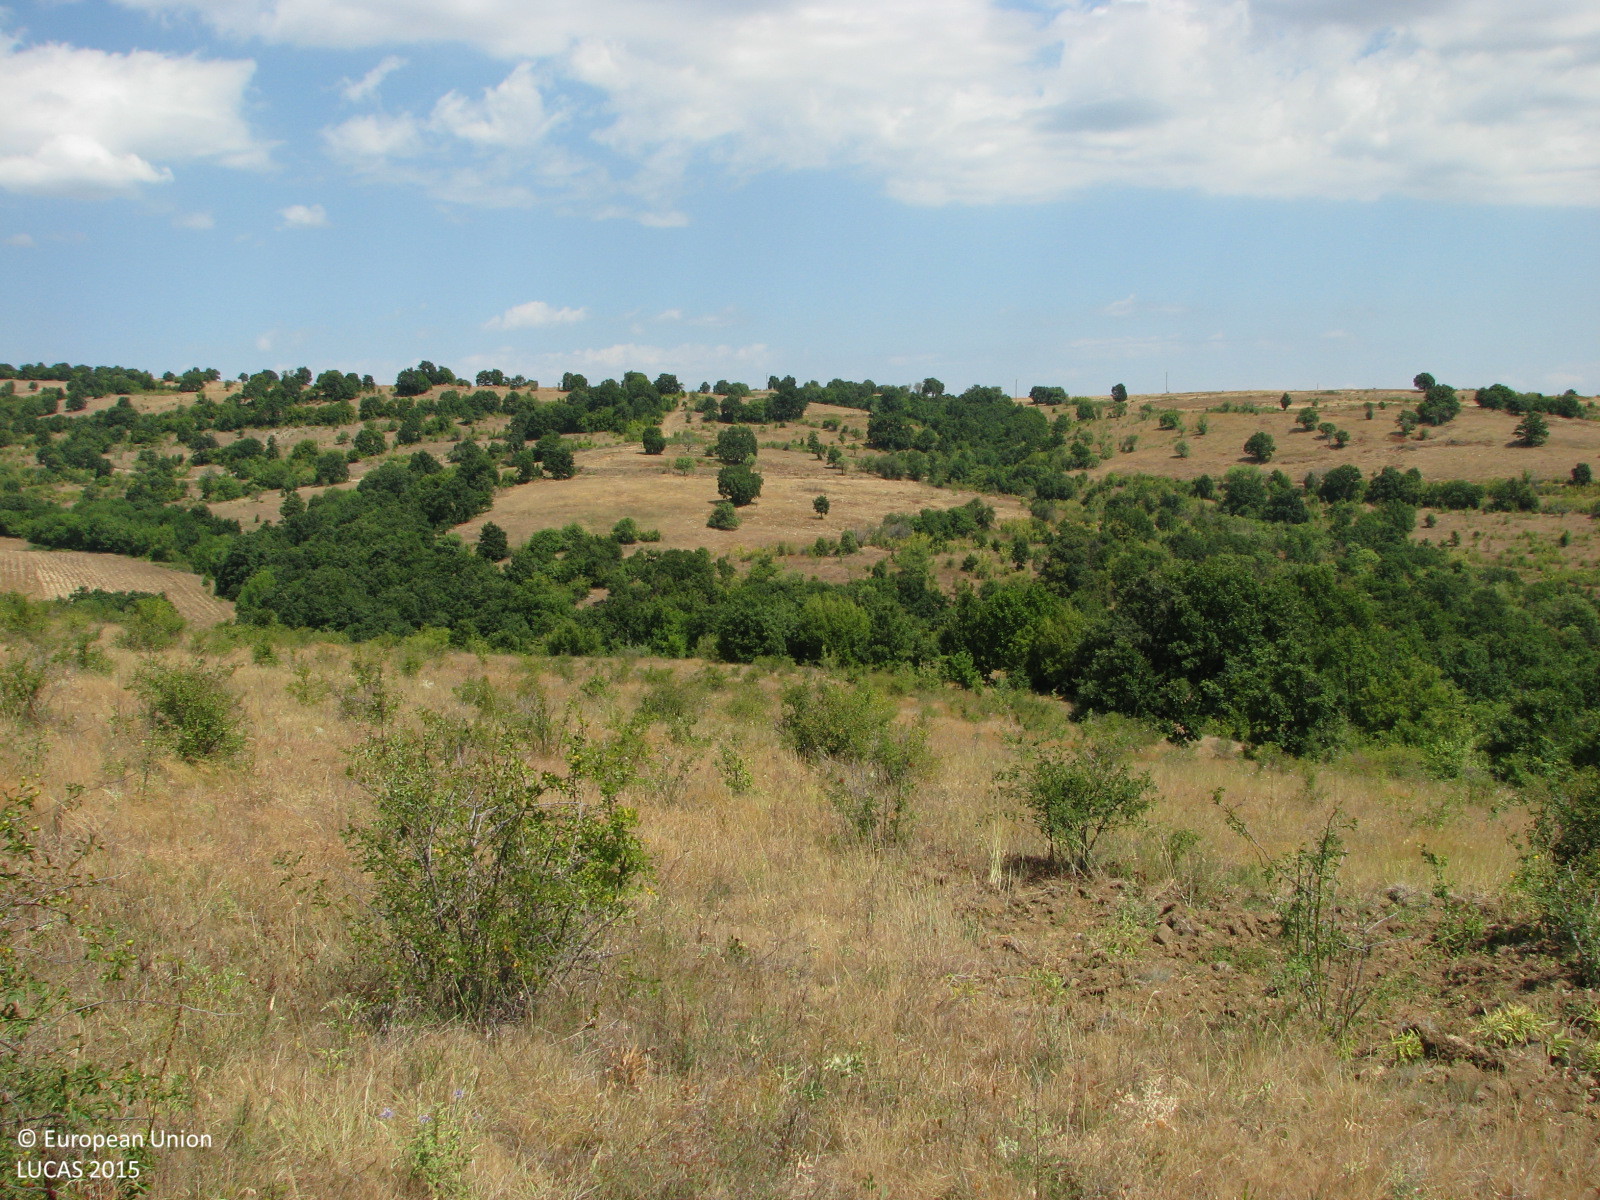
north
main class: Shrubland
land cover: Shrubland without tree cover
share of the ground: 10 - 25 %
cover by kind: herbaceous plants 80 %, shrubs 20 %
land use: Agriculture (excluding fallow land and kitchen gardens)
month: August
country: BG
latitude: 42.6877
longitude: 26.6109
